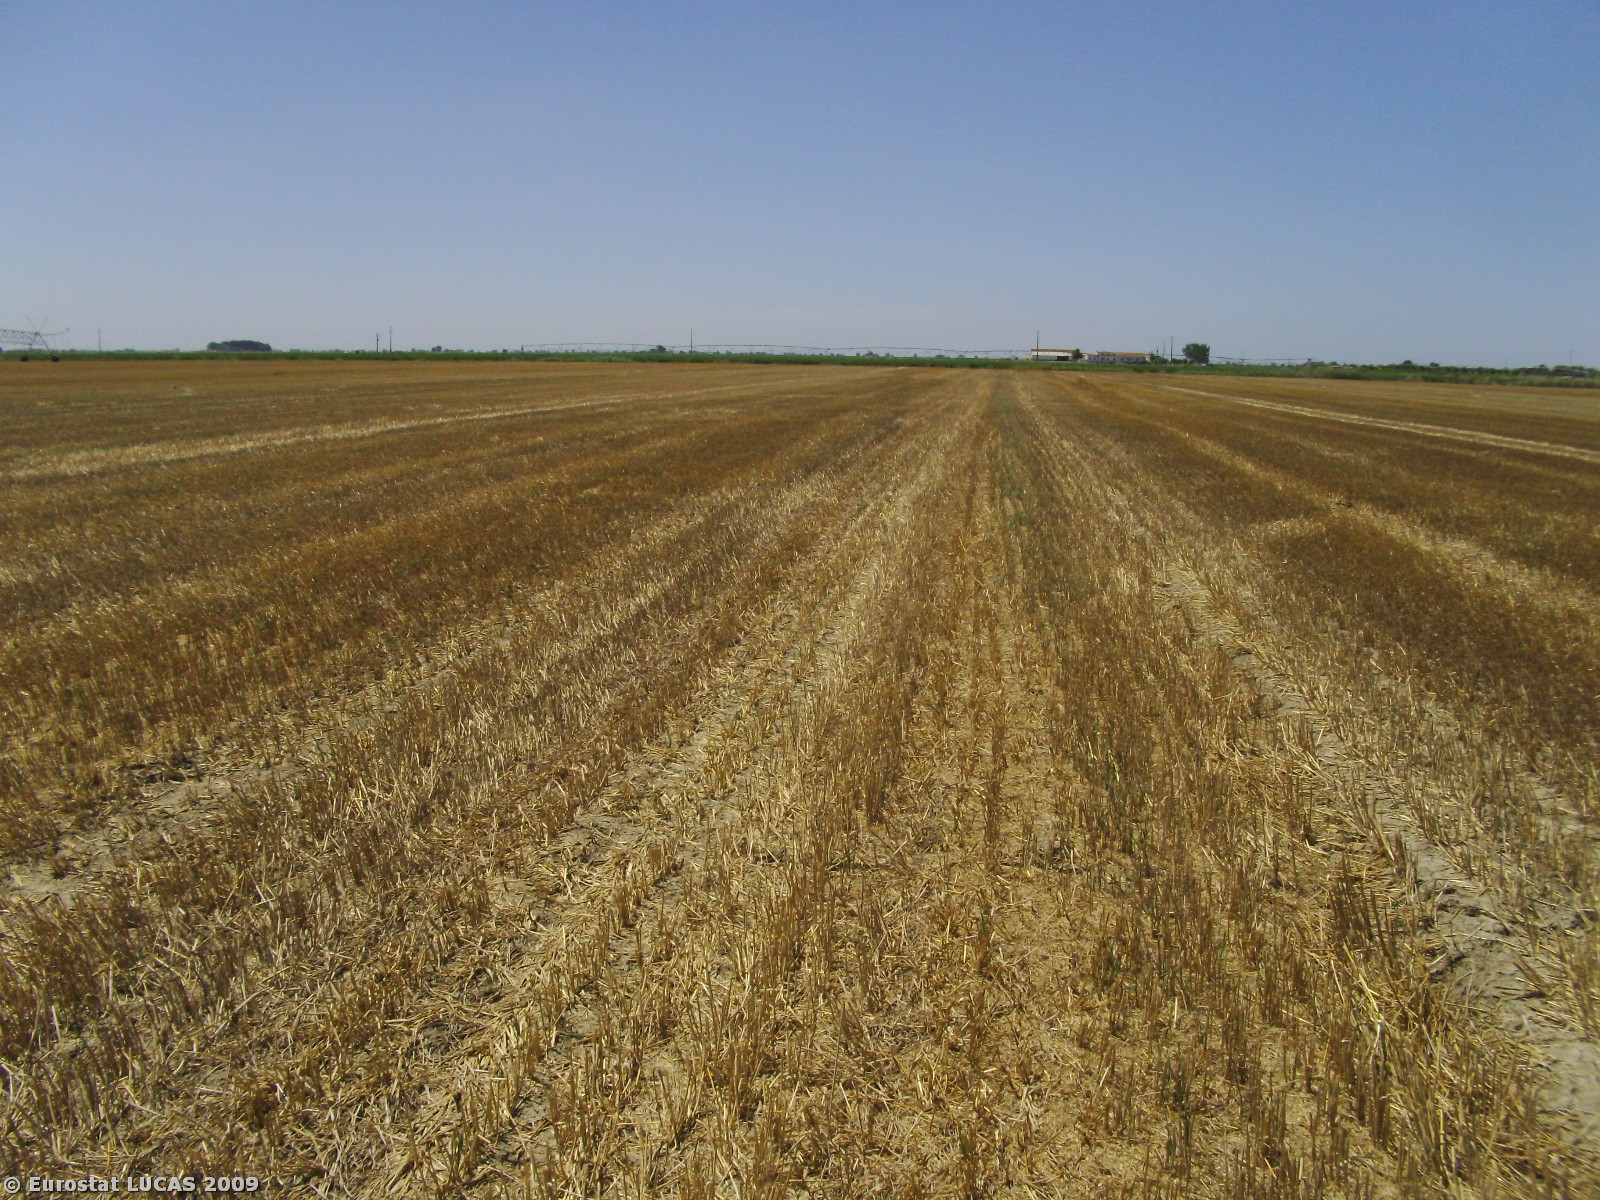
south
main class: Cropland
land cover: Common wheat
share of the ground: > 75 %
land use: Agriculture (excluding fallow land and kitchen gardens)
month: July
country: PT
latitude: 38.9981
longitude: -8.9300
